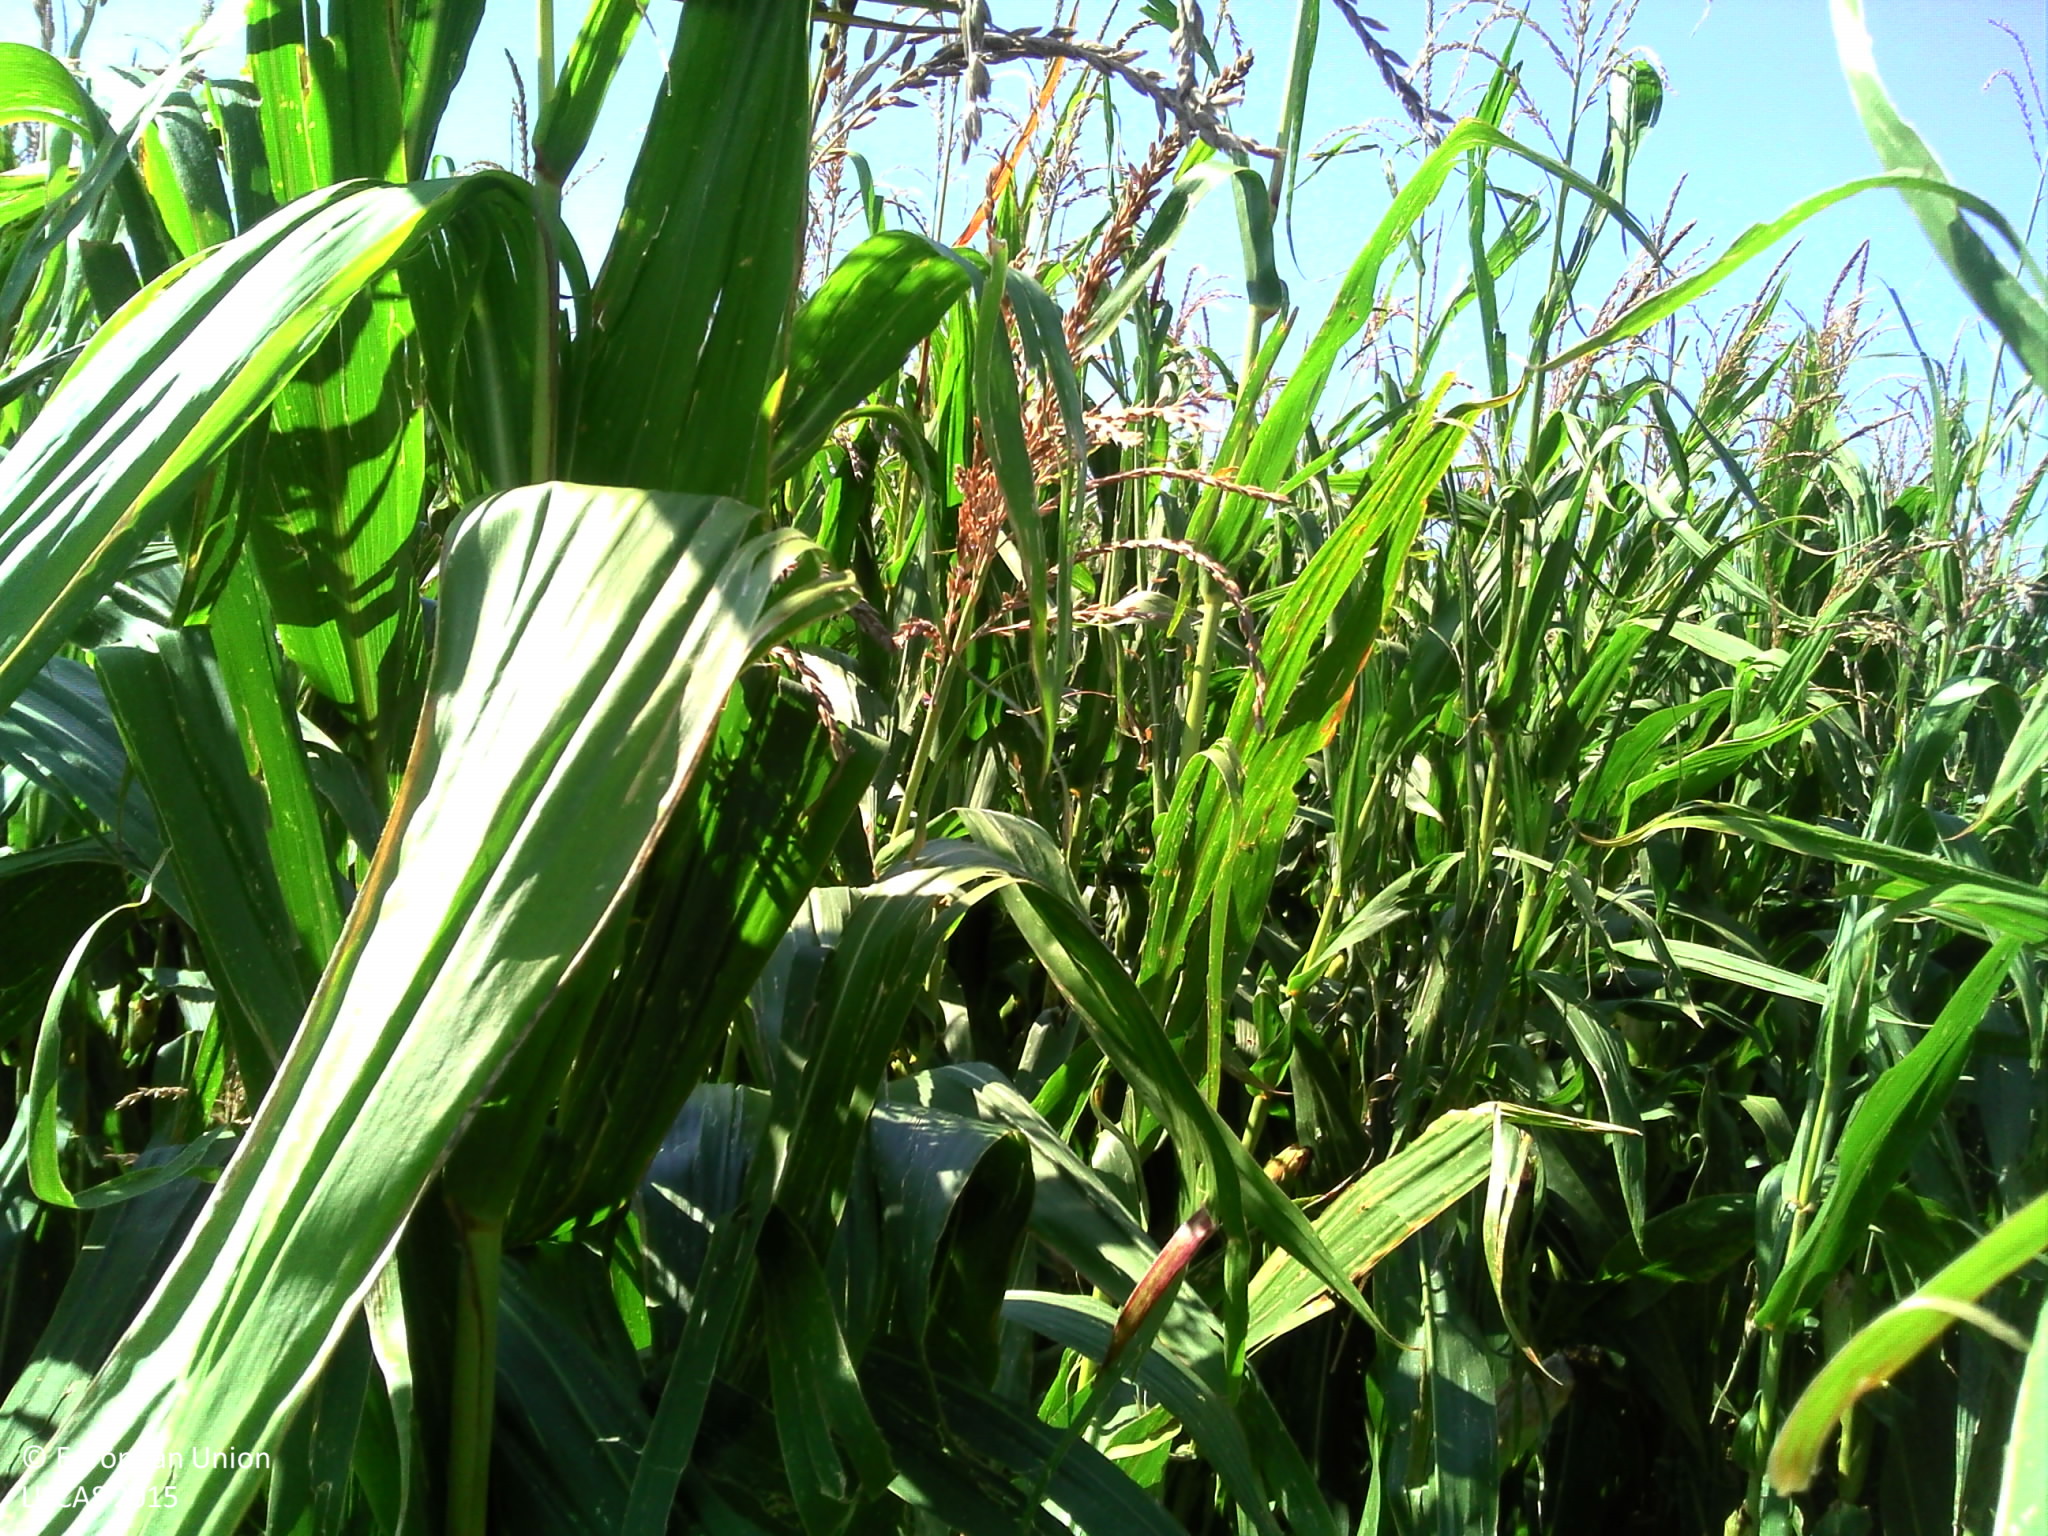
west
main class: Cropland
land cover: Maize
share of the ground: > 75 %
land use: Agriculture (excluding fallow land and kitchen gardens)
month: September
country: FR
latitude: 43.2638
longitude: -0.9139
